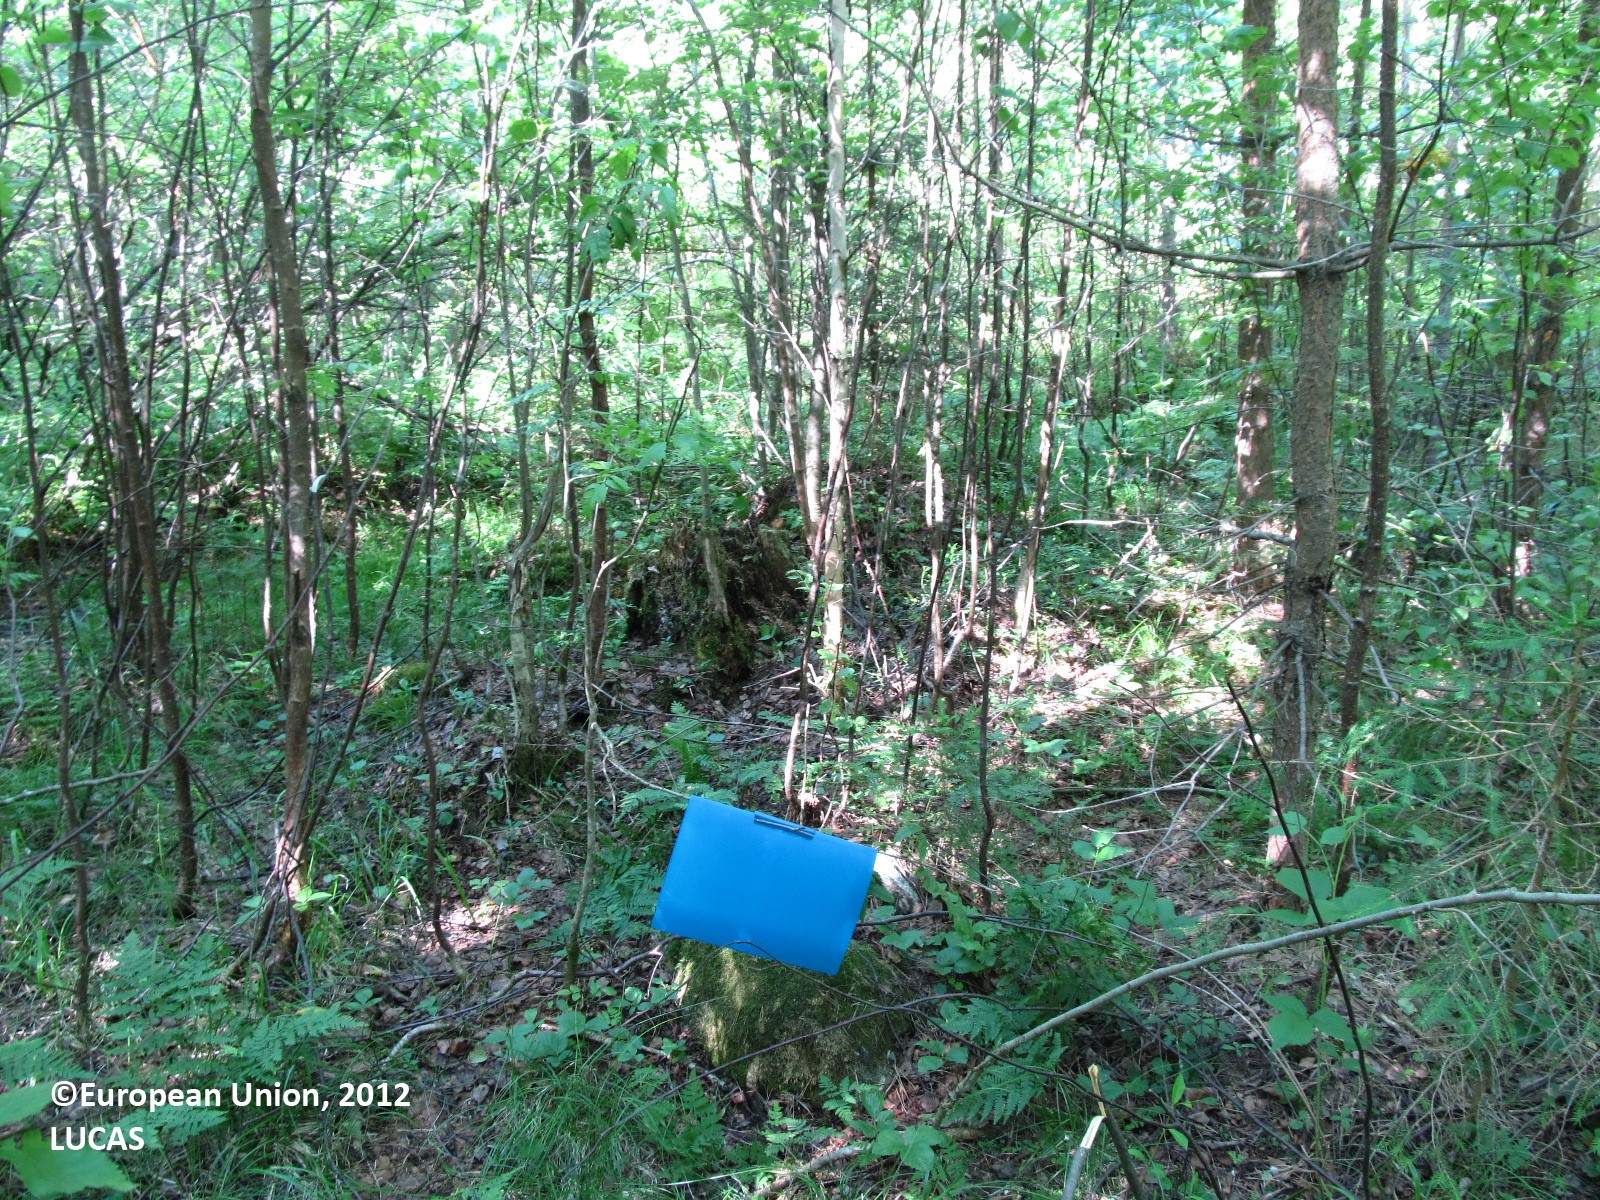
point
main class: Woodland
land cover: Broadleaved woodland
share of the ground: > 75 %
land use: Forestry
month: July
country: FI
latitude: 62.2091
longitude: 29.2469
